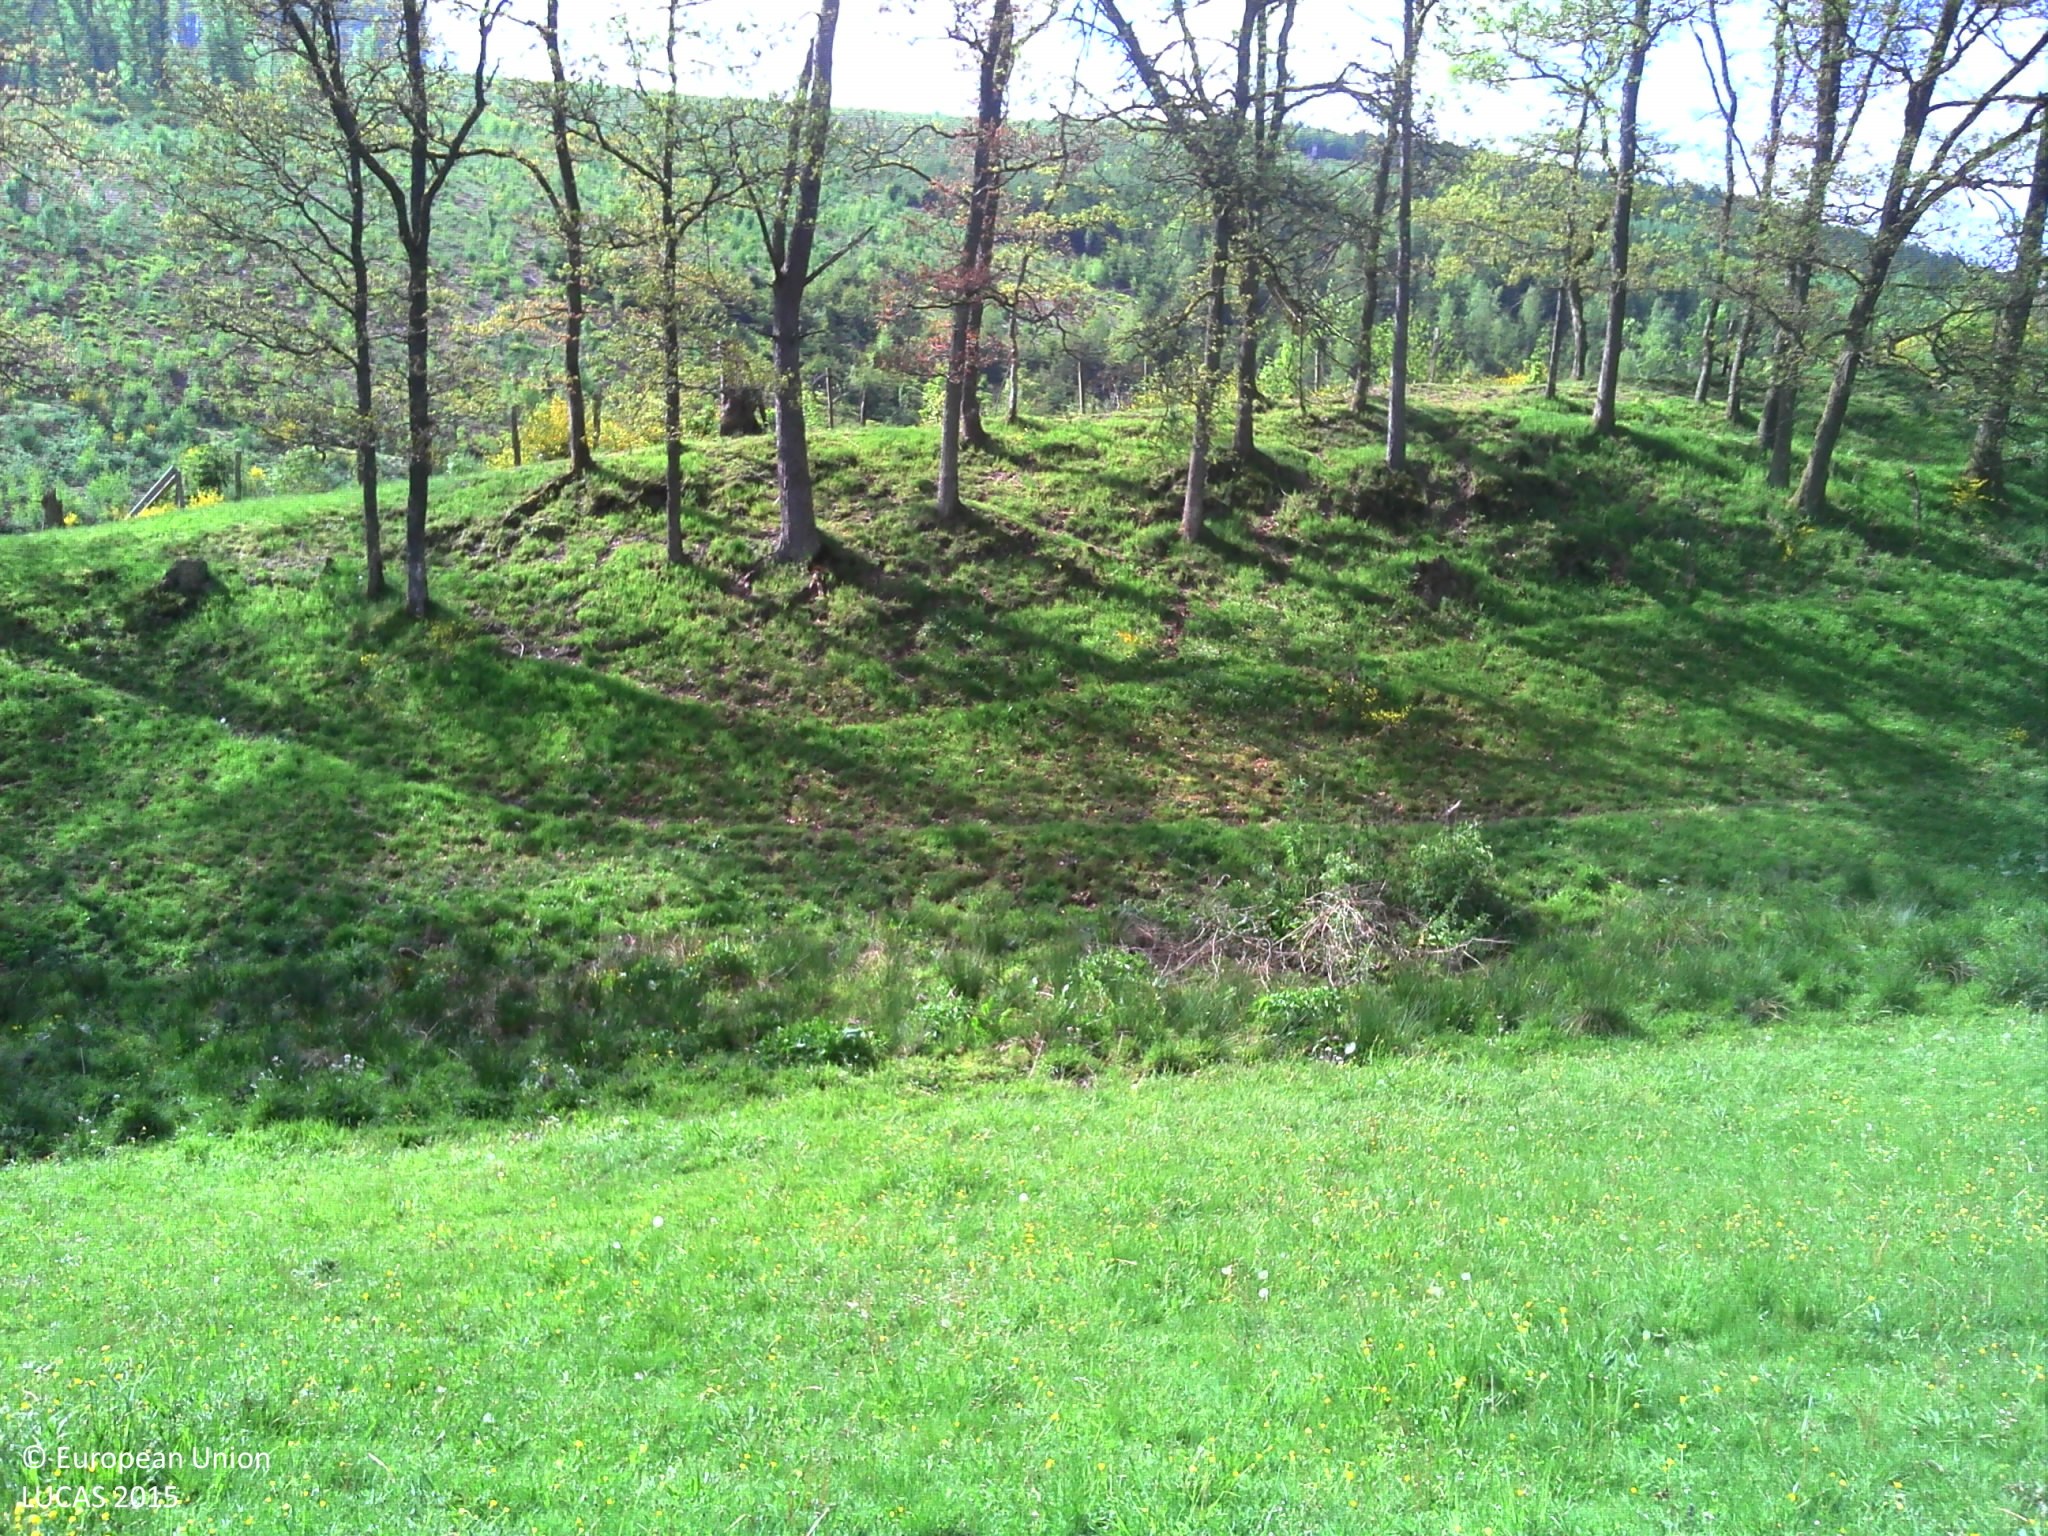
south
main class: Grassland
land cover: Grassland without tree/shrub cover
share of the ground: > 75 %
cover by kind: herbaceous plants 100 %
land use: Agriculture (excluding fallow land and kitchen gardens)
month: May
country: LU
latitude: 50.0398
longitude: 5.9359
